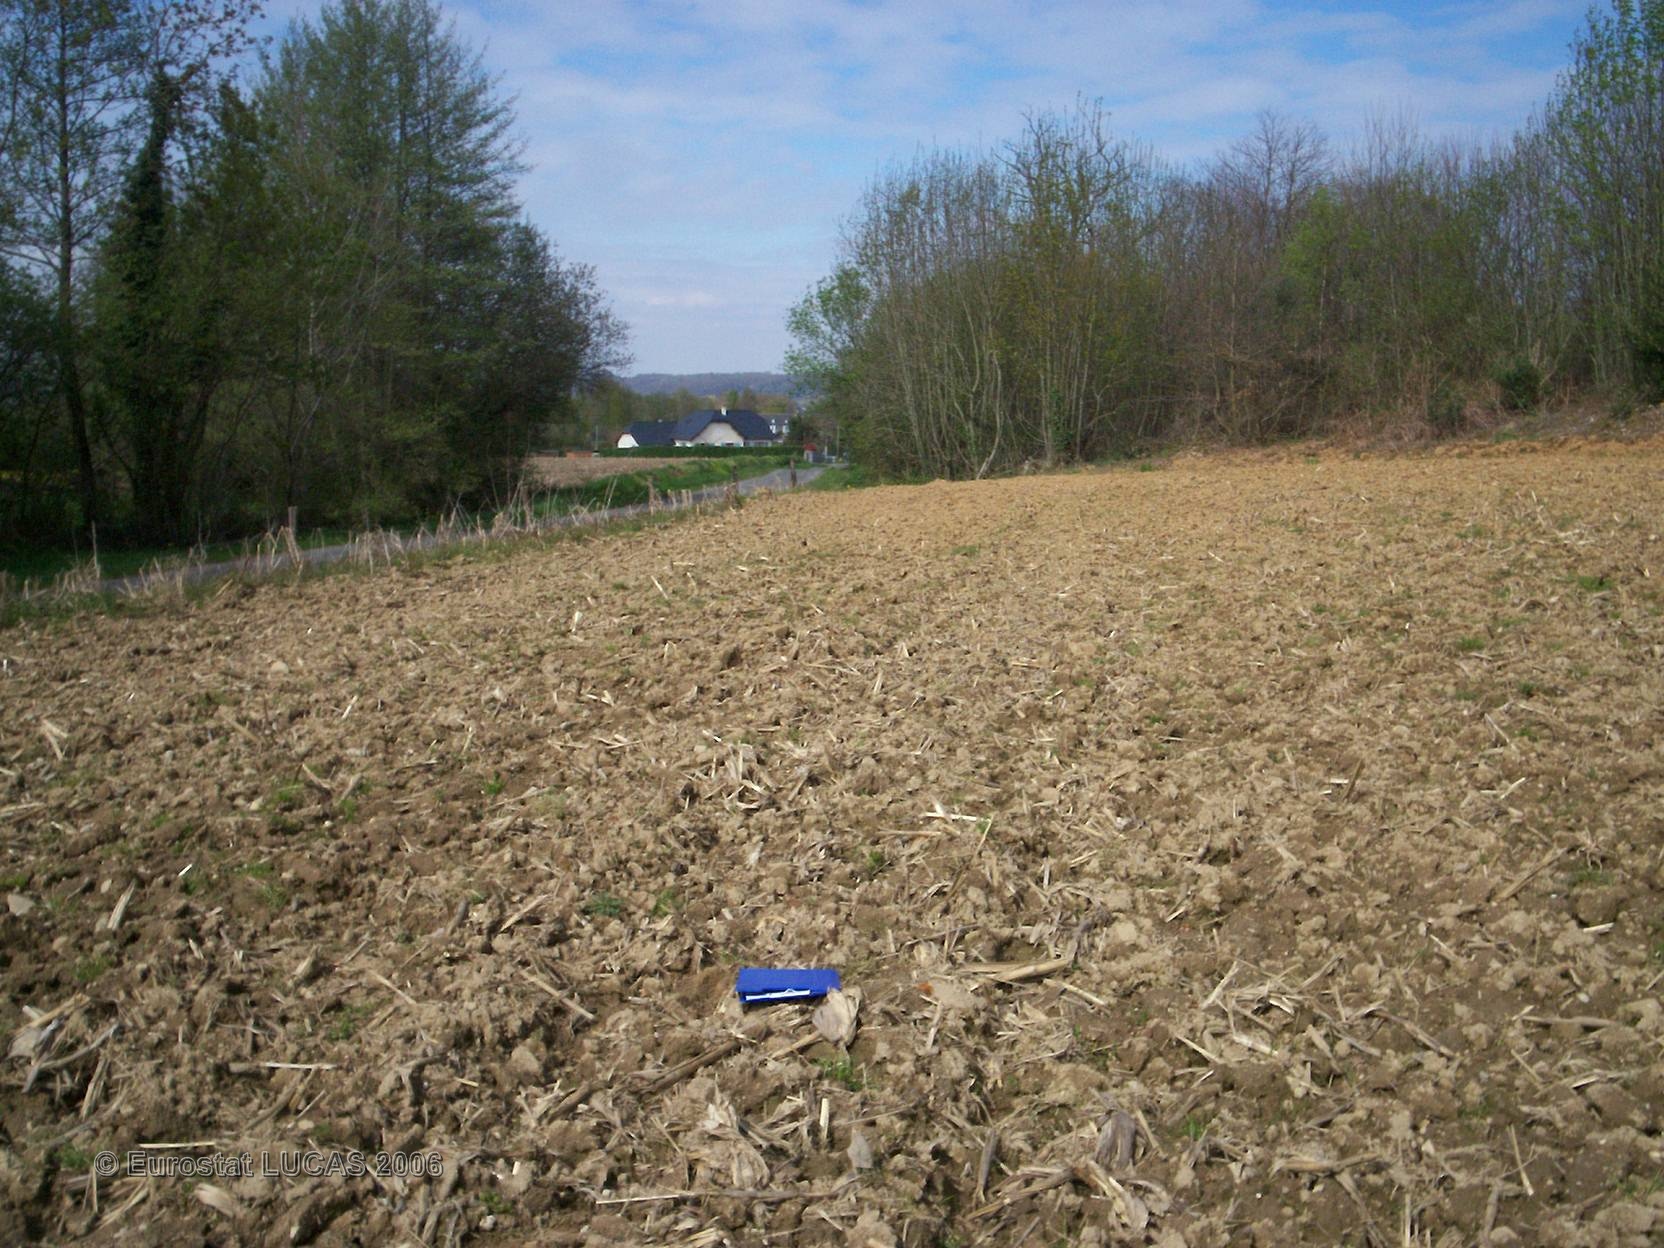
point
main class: Grassland
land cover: Grassland without tree/shrub cover
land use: Agriculture (excluding fallow land and kitchen gardens)
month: June
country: FR
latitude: 43.1635
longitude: -0.1264
